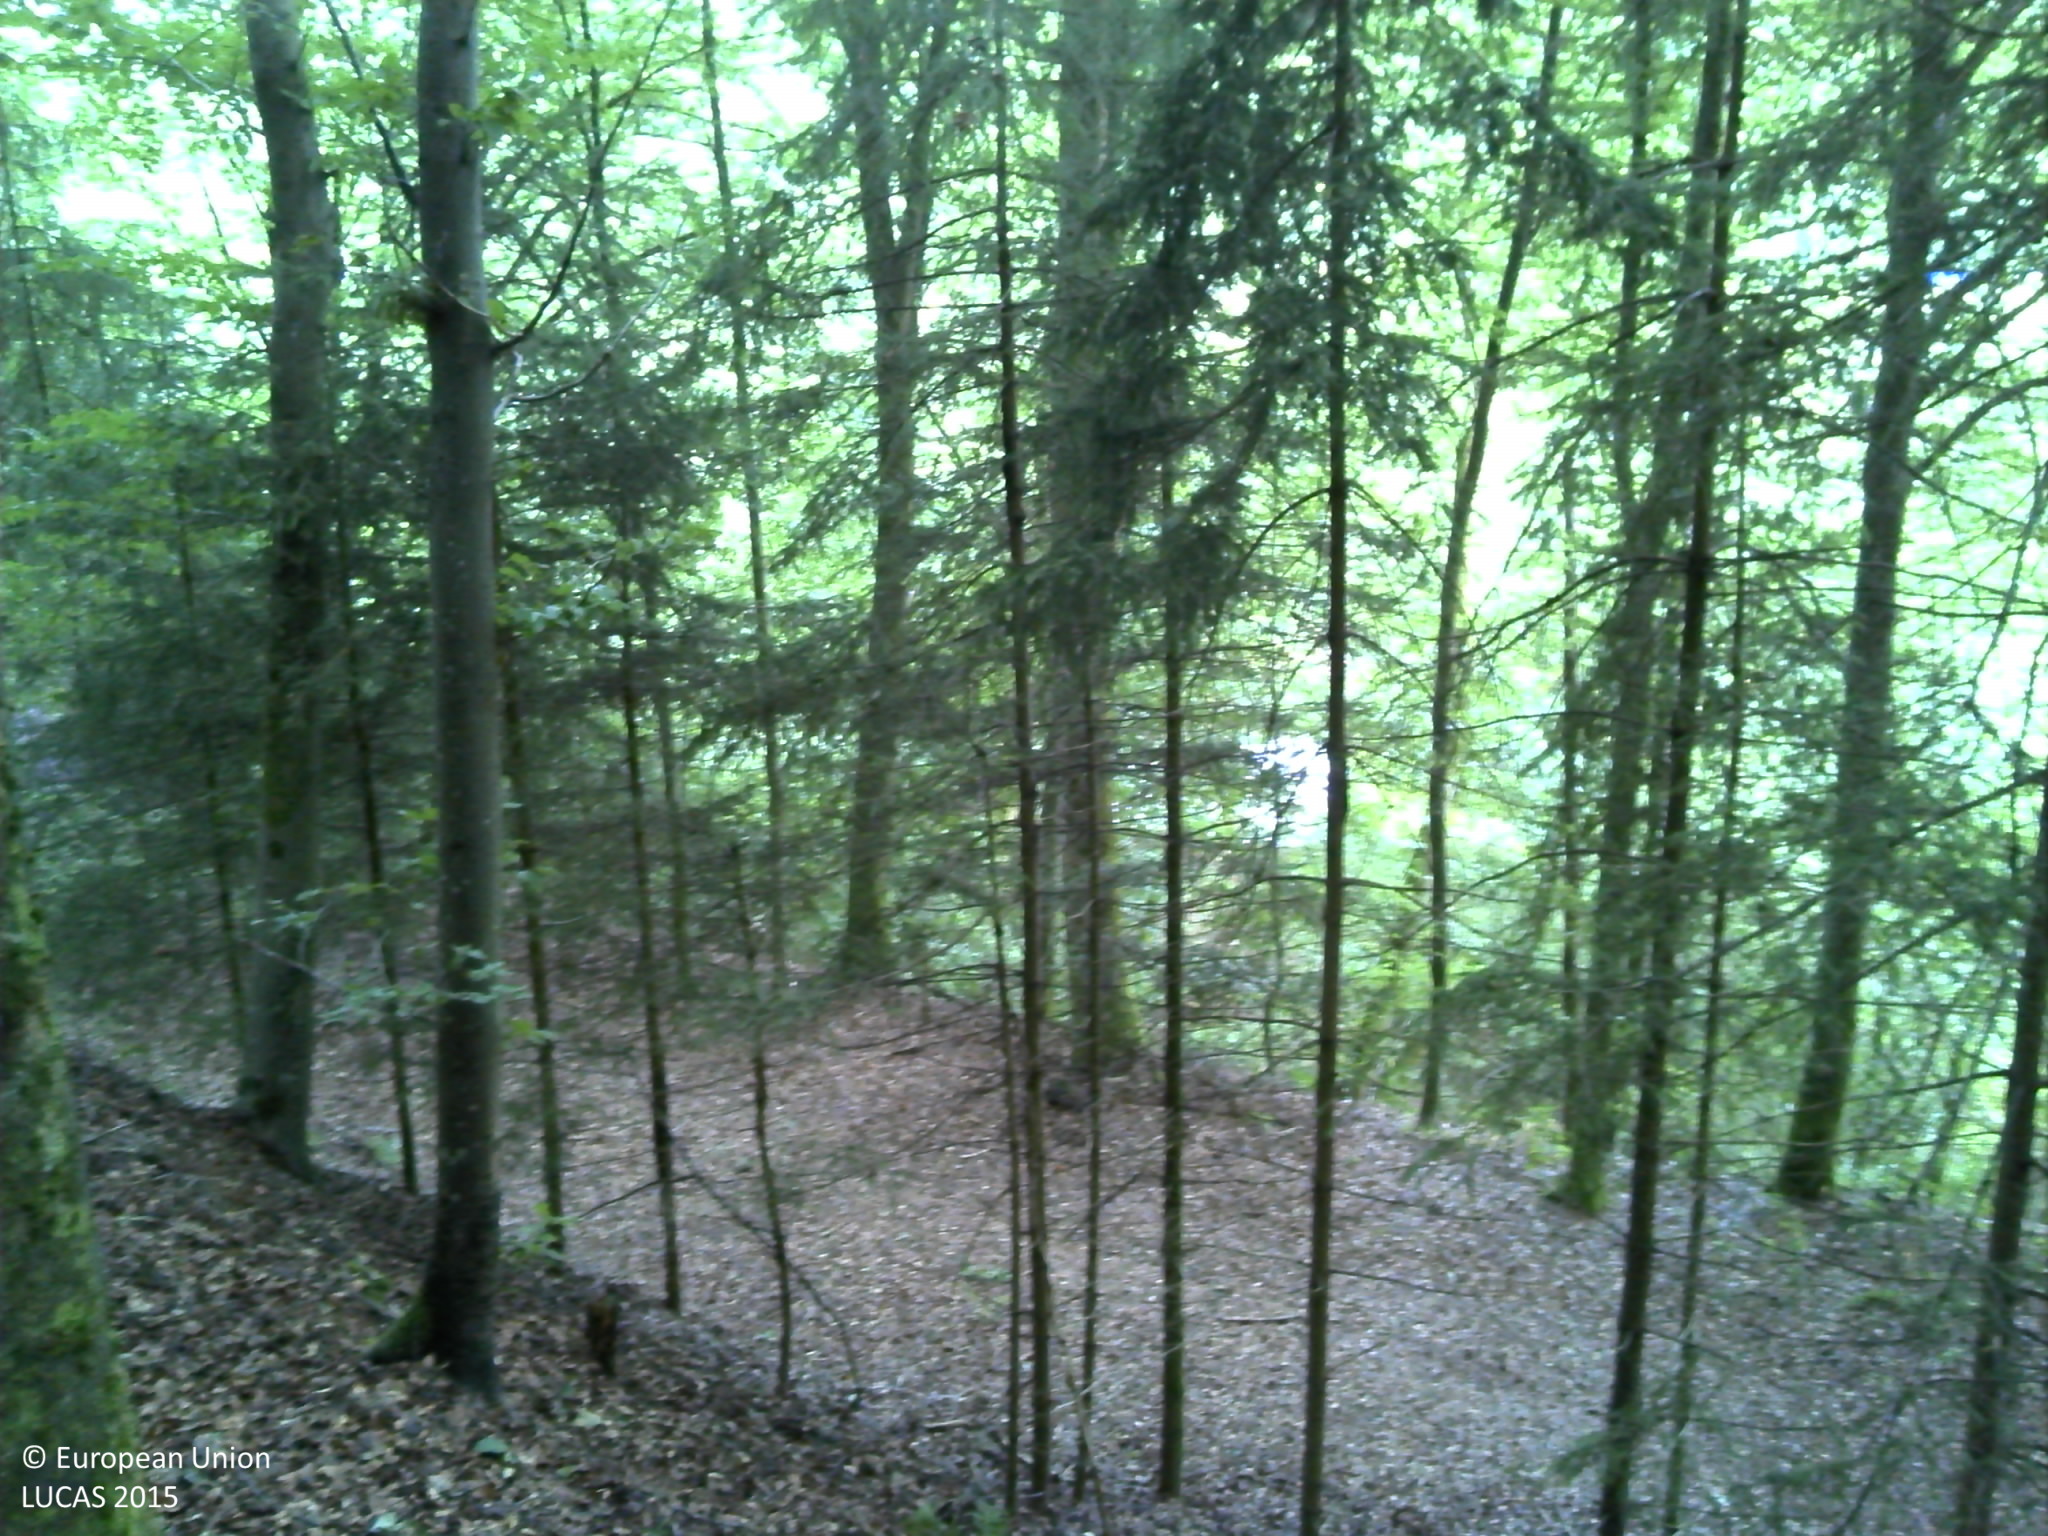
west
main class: Woodland
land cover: Spruce dominated mixed woodland
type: alpine coniferous forest
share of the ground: > 75 %
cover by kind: broadleaved forest trees 60 %, coniferous forest trees 40 %
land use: Forestry
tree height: > 5 m
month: July
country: FR
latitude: 48.1163
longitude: 6.5755
